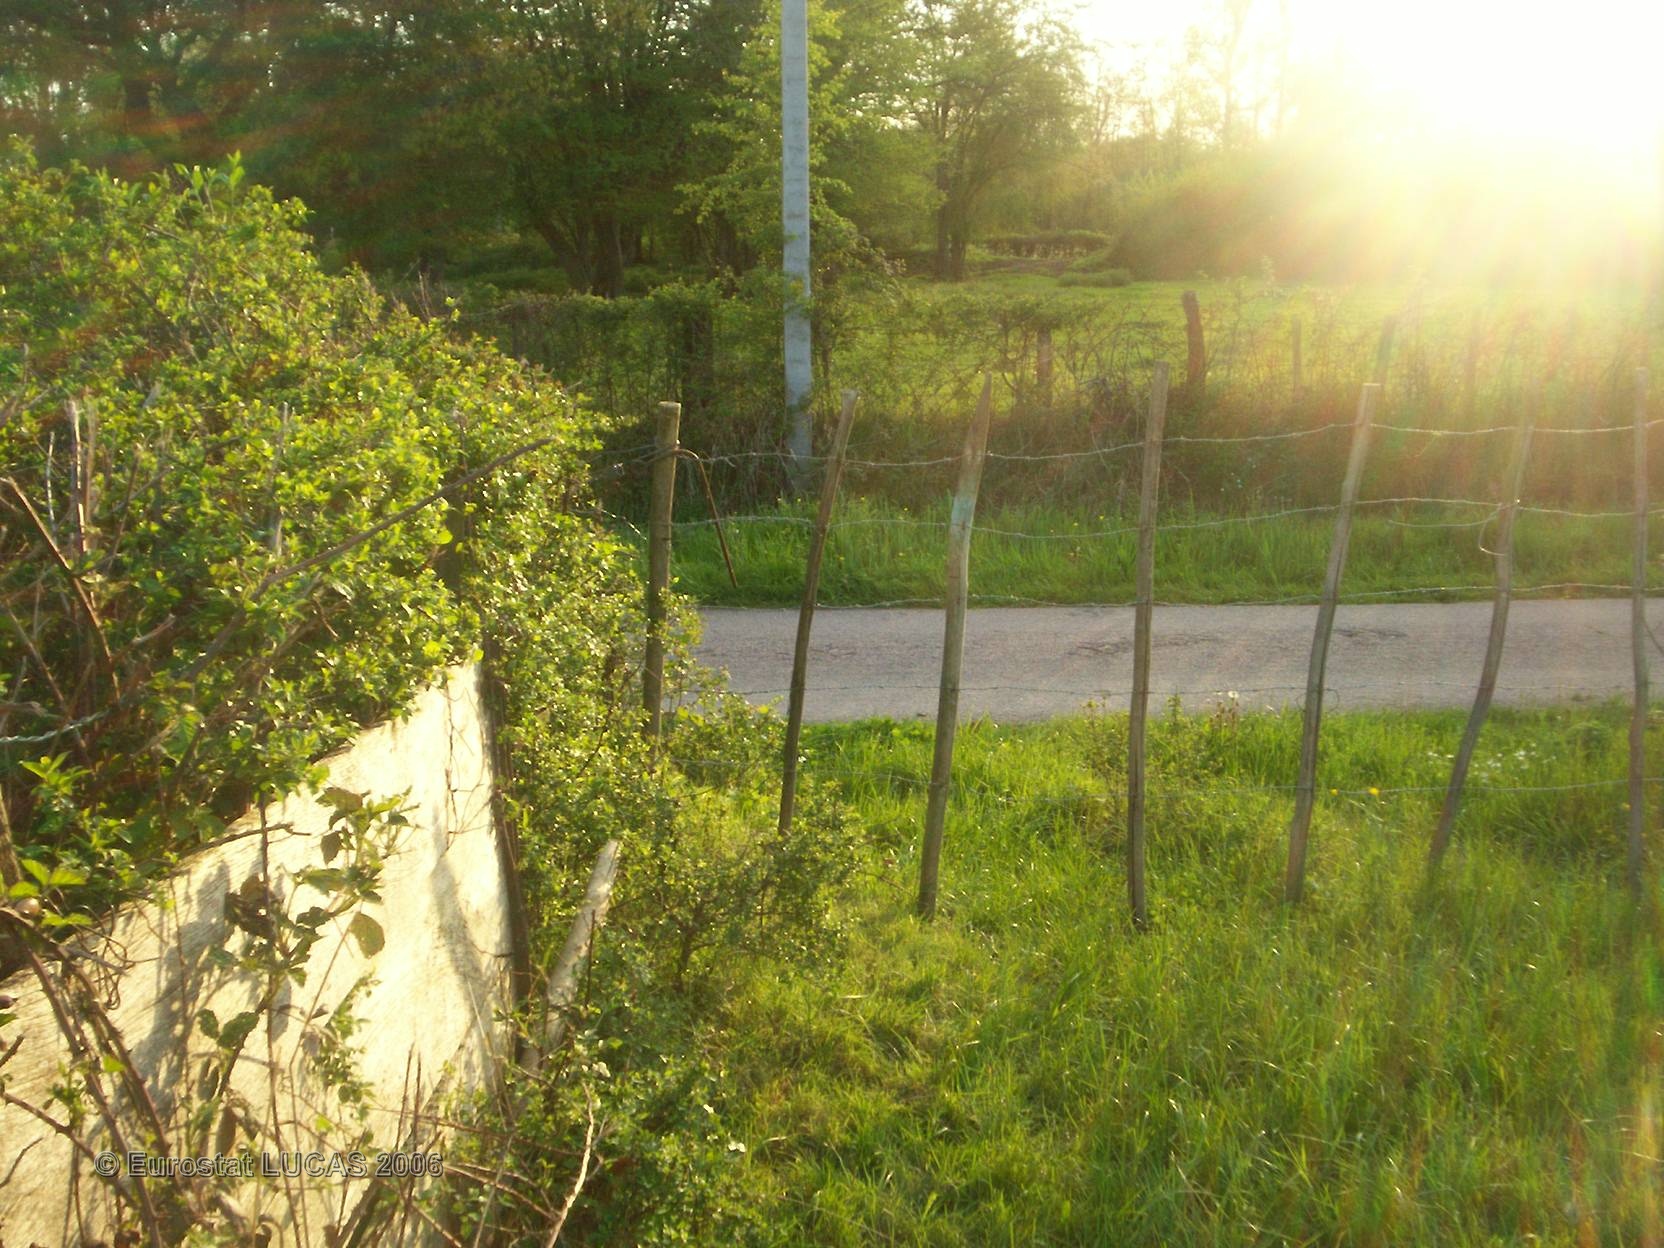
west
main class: Grassland
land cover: Grassland without tree/shrub cover
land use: Agriculture (excluding fallow land and kitchen gardens)
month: May
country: FR
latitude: 46.2375
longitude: 3.1123
